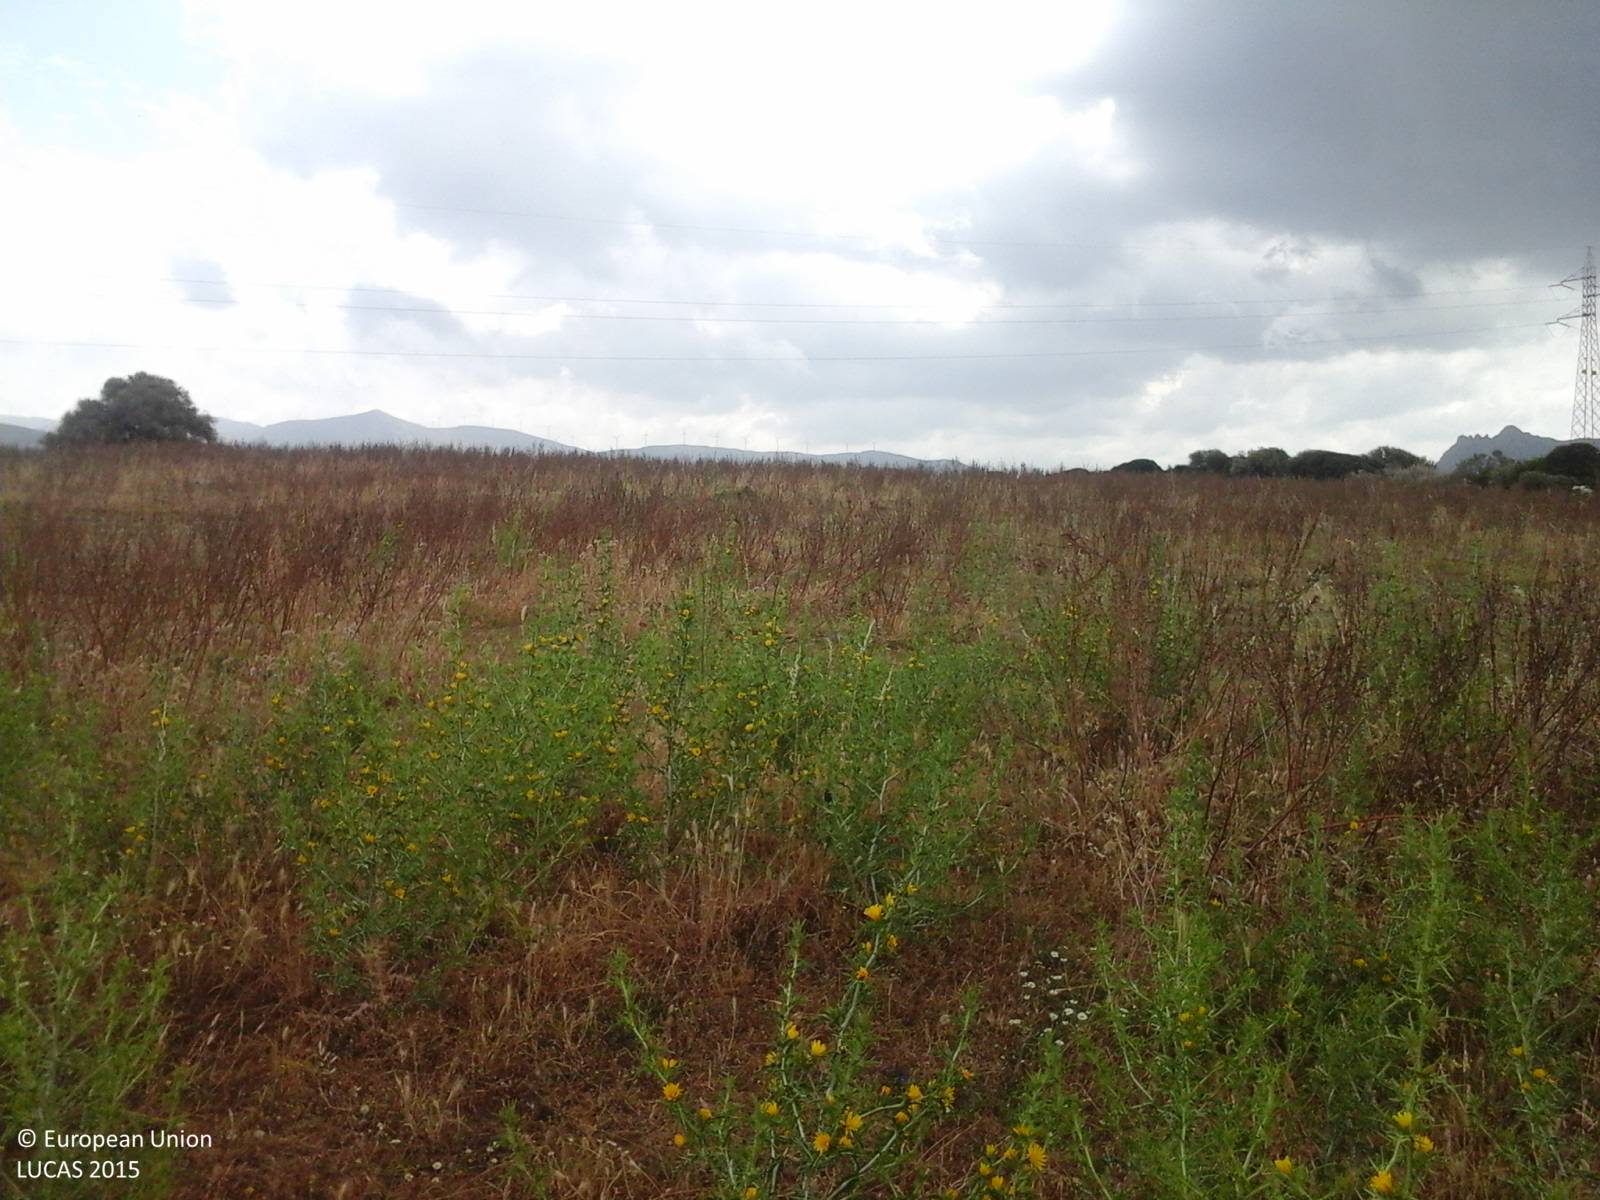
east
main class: Grassland
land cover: Spontaneously vegetated surfaces
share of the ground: > 75 %
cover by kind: herbaceous plants 100 %
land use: Agriculture (excluding fallow land and kitchen gardens)
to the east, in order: Spontaneously vegetated surfaces; Electric lines; Spontaneously vegetated surfaces; Fences; Dry stone walls; Shrubland with sparse tree cover
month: May
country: IT
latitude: 40.9305
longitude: 8.8770
